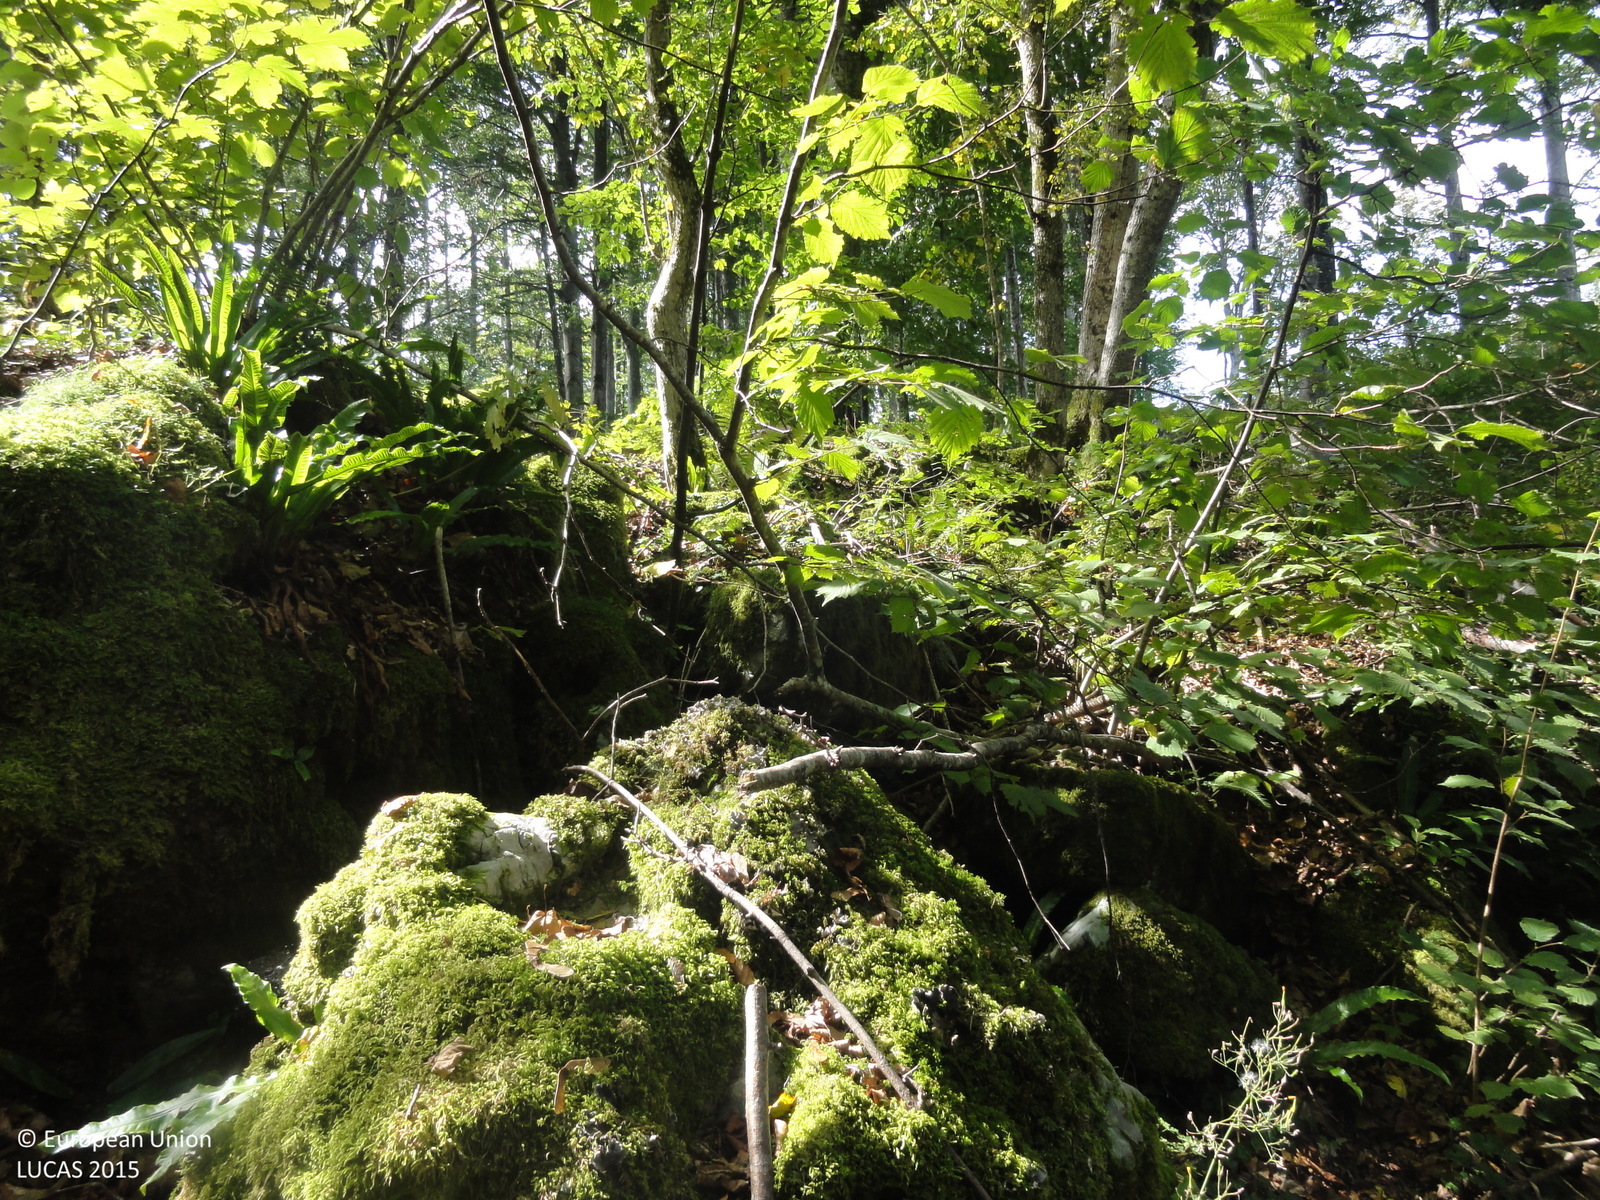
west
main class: Woodland
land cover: Broadleaved woodland
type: beech forest
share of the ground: > 75 %
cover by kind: broadleaved forest trees 90 %, coniferous forest trees 10 %
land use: Forestry
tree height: > 5 m
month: September
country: SI
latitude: 45.5806
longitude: 15.0838
